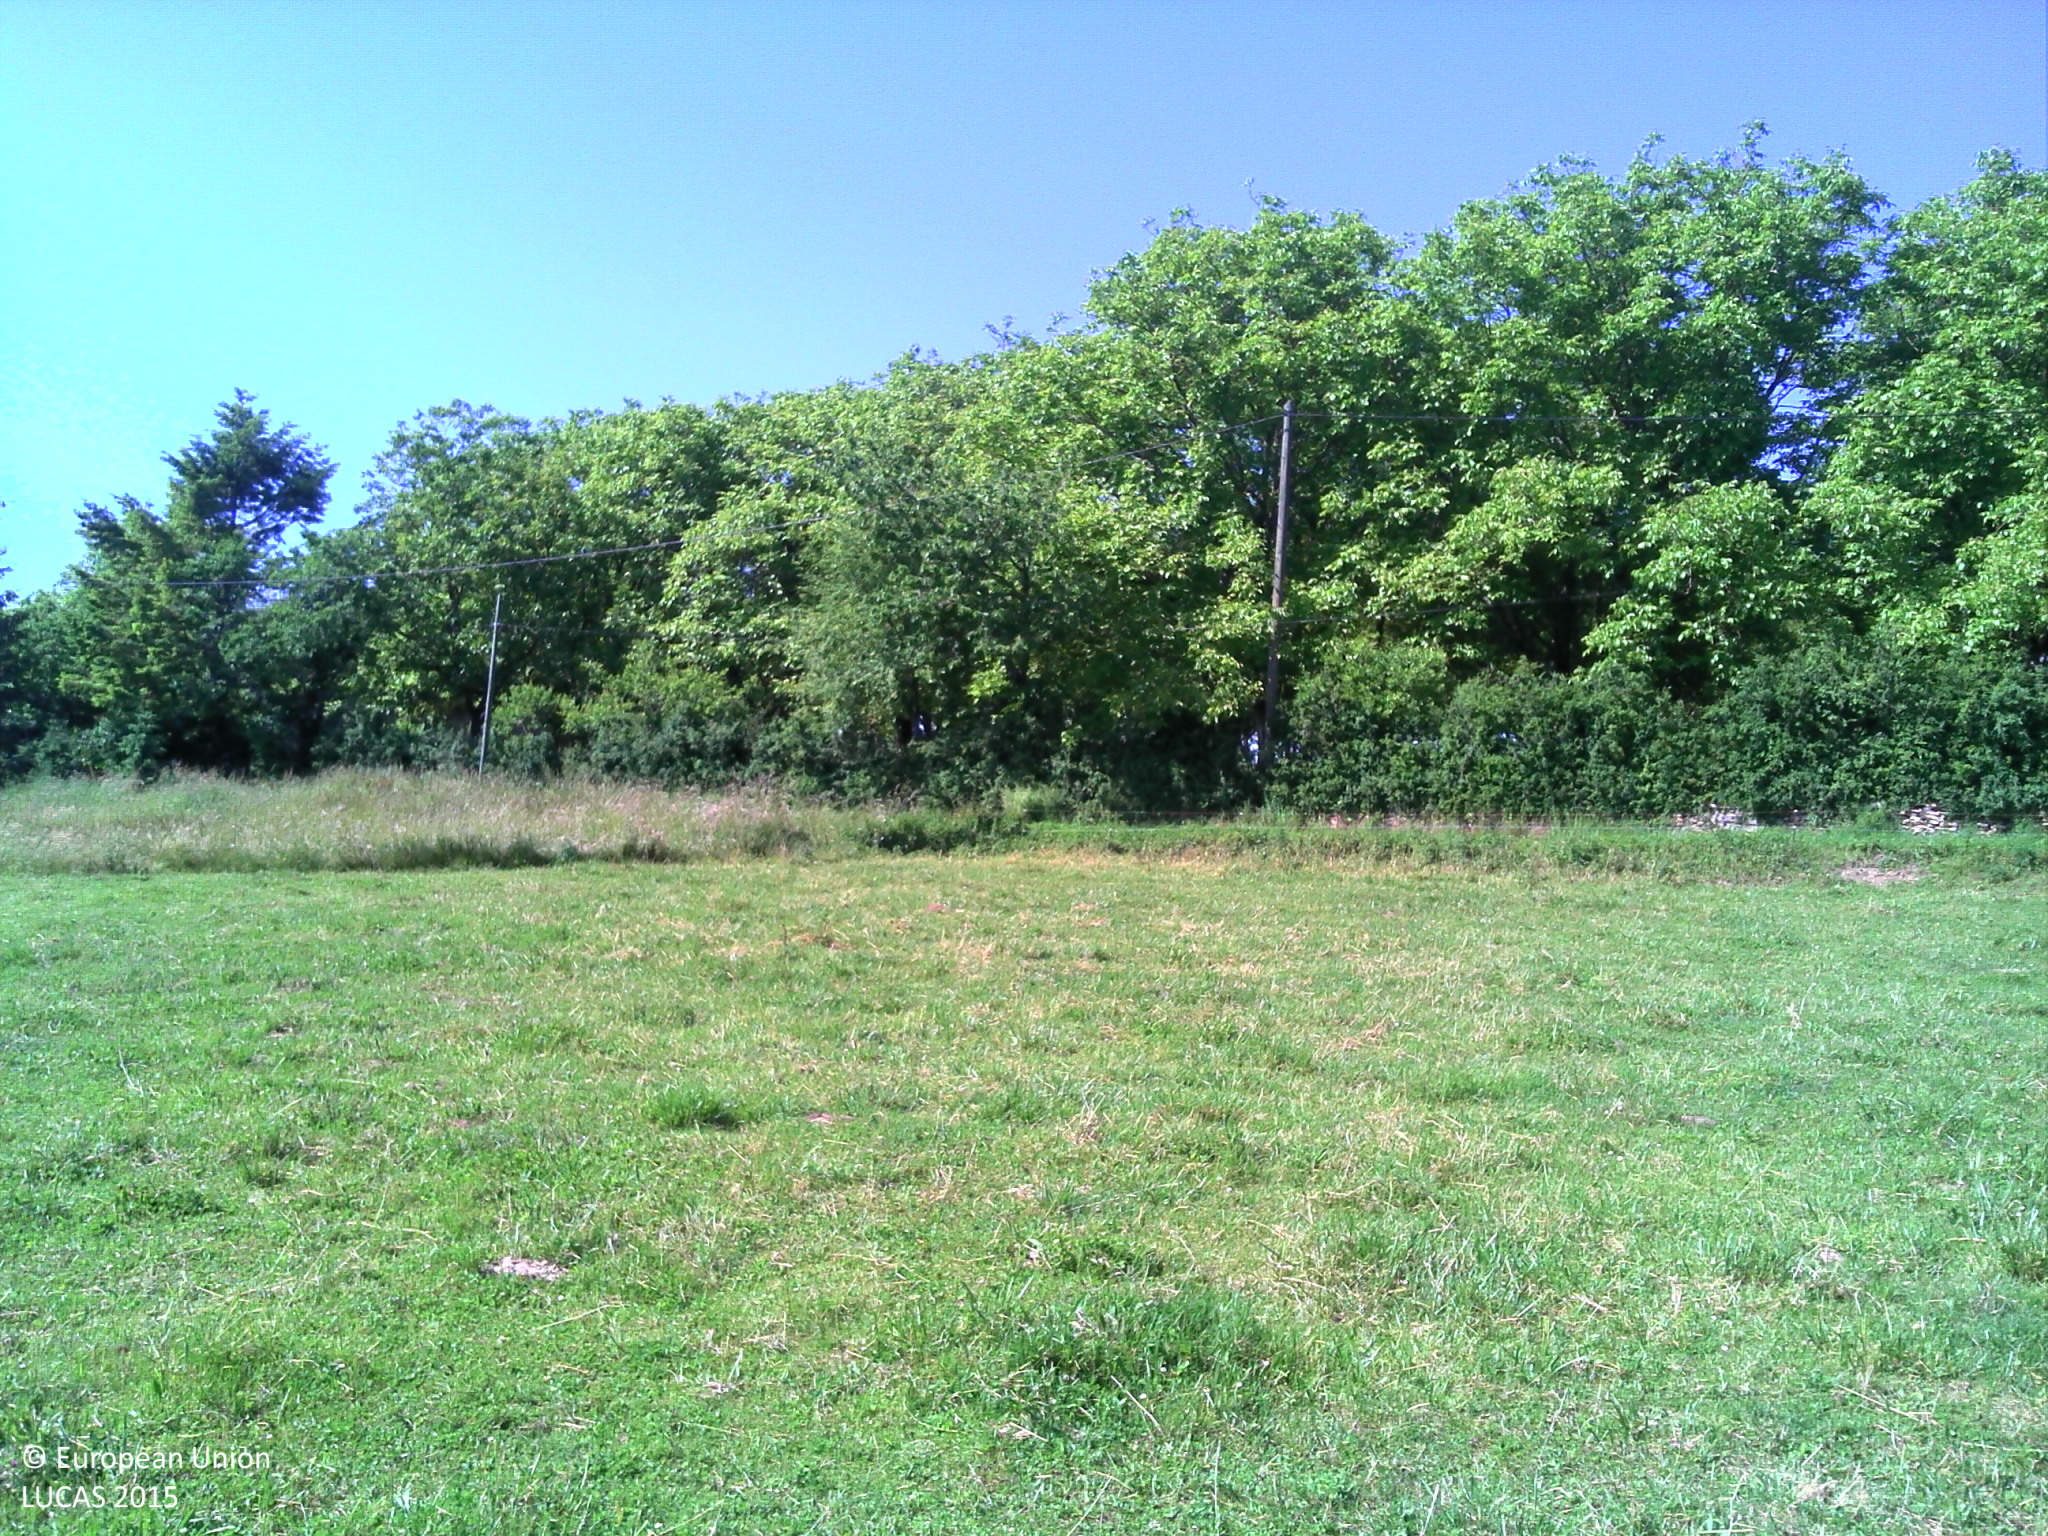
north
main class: Grassland
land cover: Grassland without tree/shrub cover
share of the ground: > 75 %
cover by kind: herbaceous plants 100 %
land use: Agriculture (excluding fallow land and kitchen gardens)
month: May
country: FR
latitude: 44.6566
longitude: 1.9920
